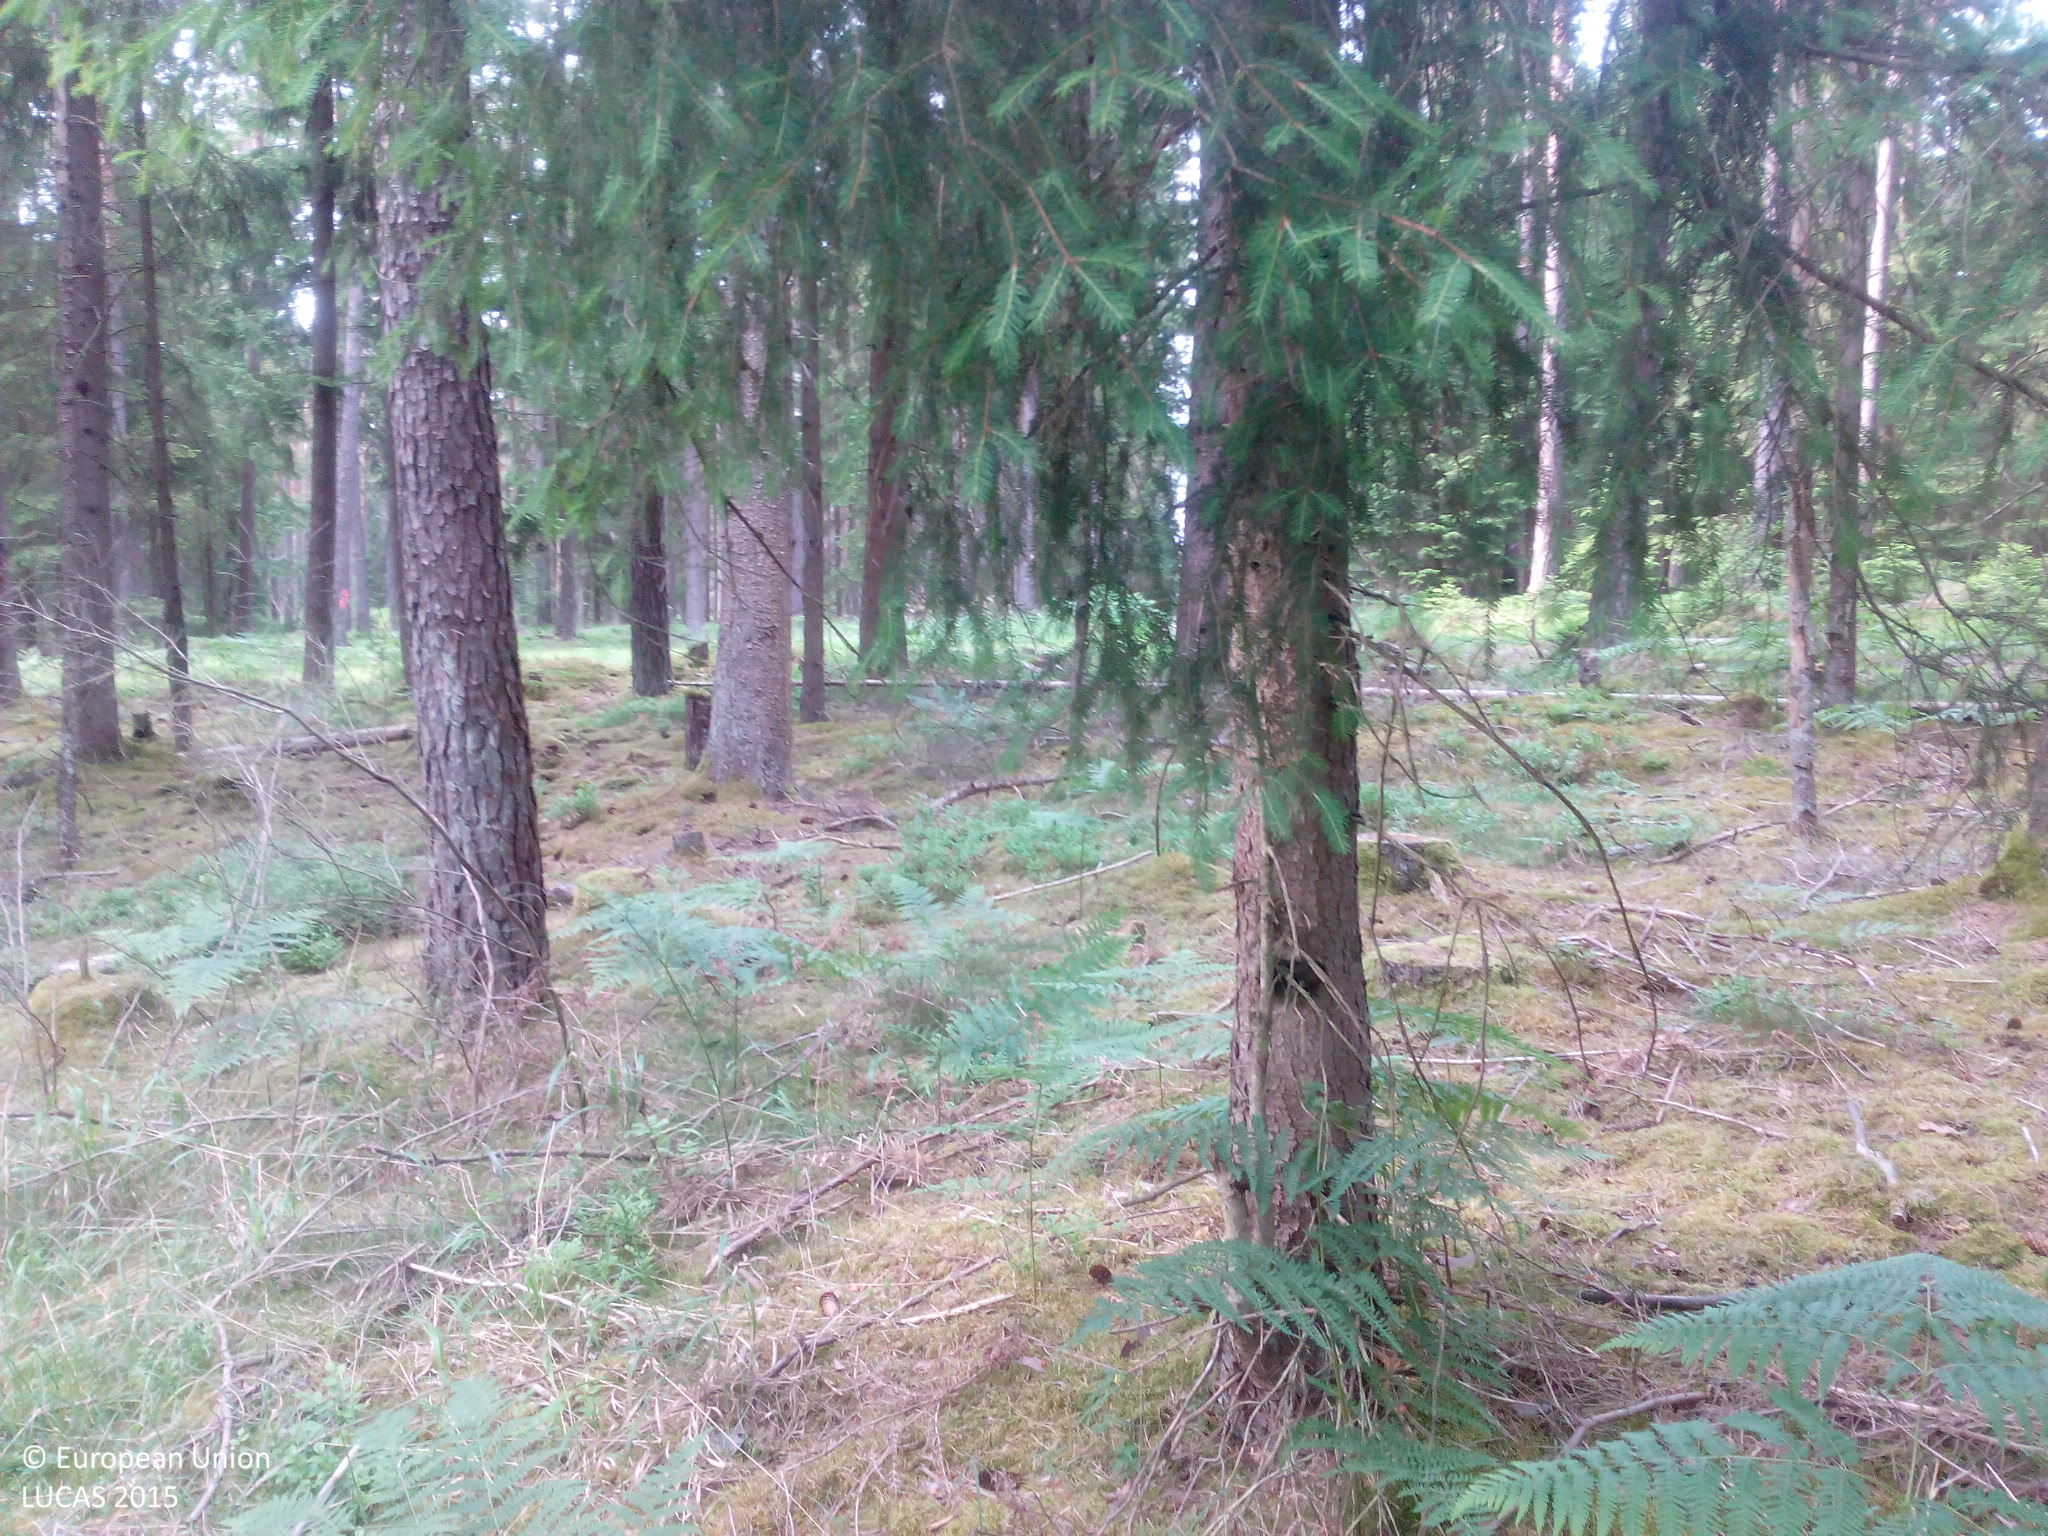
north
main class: Woodland
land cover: Other coniferous woodland
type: hemiboreal forest and nemoral coniferous forest and mixed broadleaved-coniferous forest
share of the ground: 50 - 75 %
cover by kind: coniferous forest trees 70 %, herbaceous plants 25 %, lichens and mosses 5 %
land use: Forestry
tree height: > 5 m
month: June
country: DE
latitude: 49.7069
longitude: 11.4833
